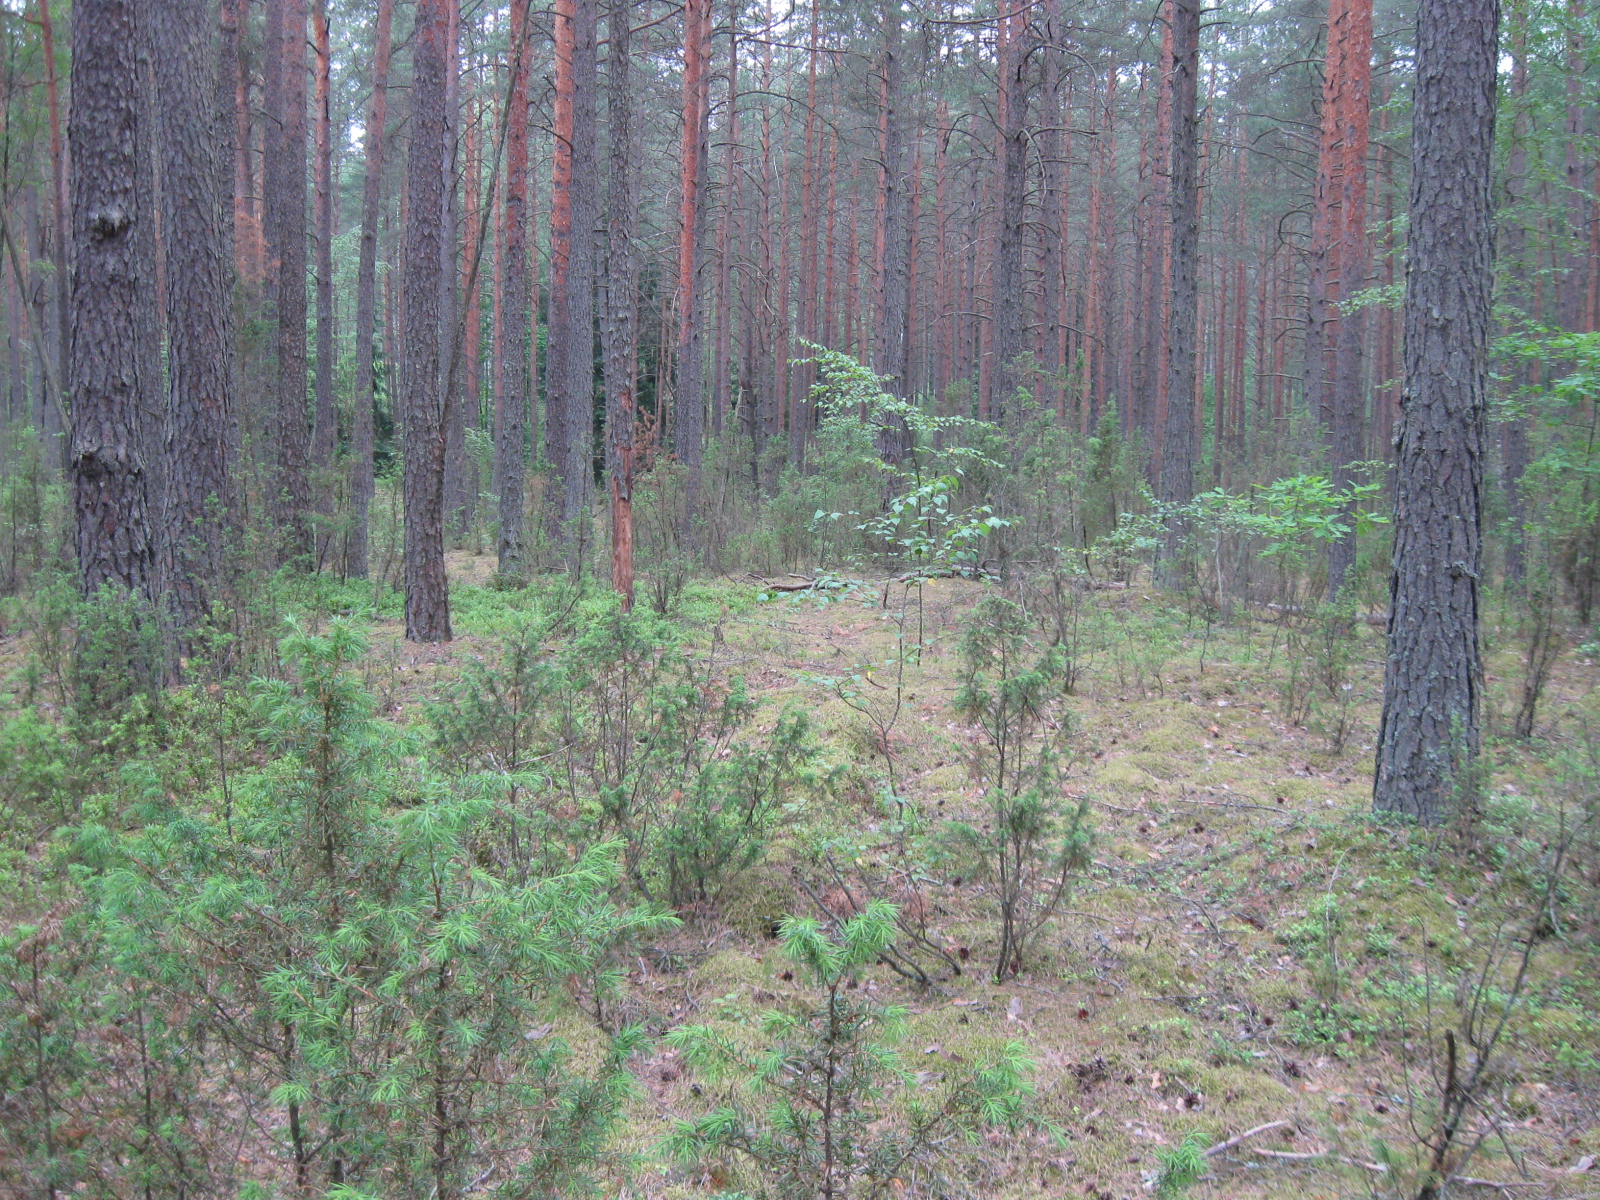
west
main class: Woodland
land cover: Pine dominated coniferous woodland
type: hemiboreal forest and nemoral coniferous forest and mixed broadleaved-coniferous forest
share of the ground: > 75 %
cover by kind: coniferous forest trees 95 %, lichens and mosses 5 %
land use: Forestry
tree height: > 5 m
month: July
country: LT
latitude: 54.1388
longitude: 24.2883
